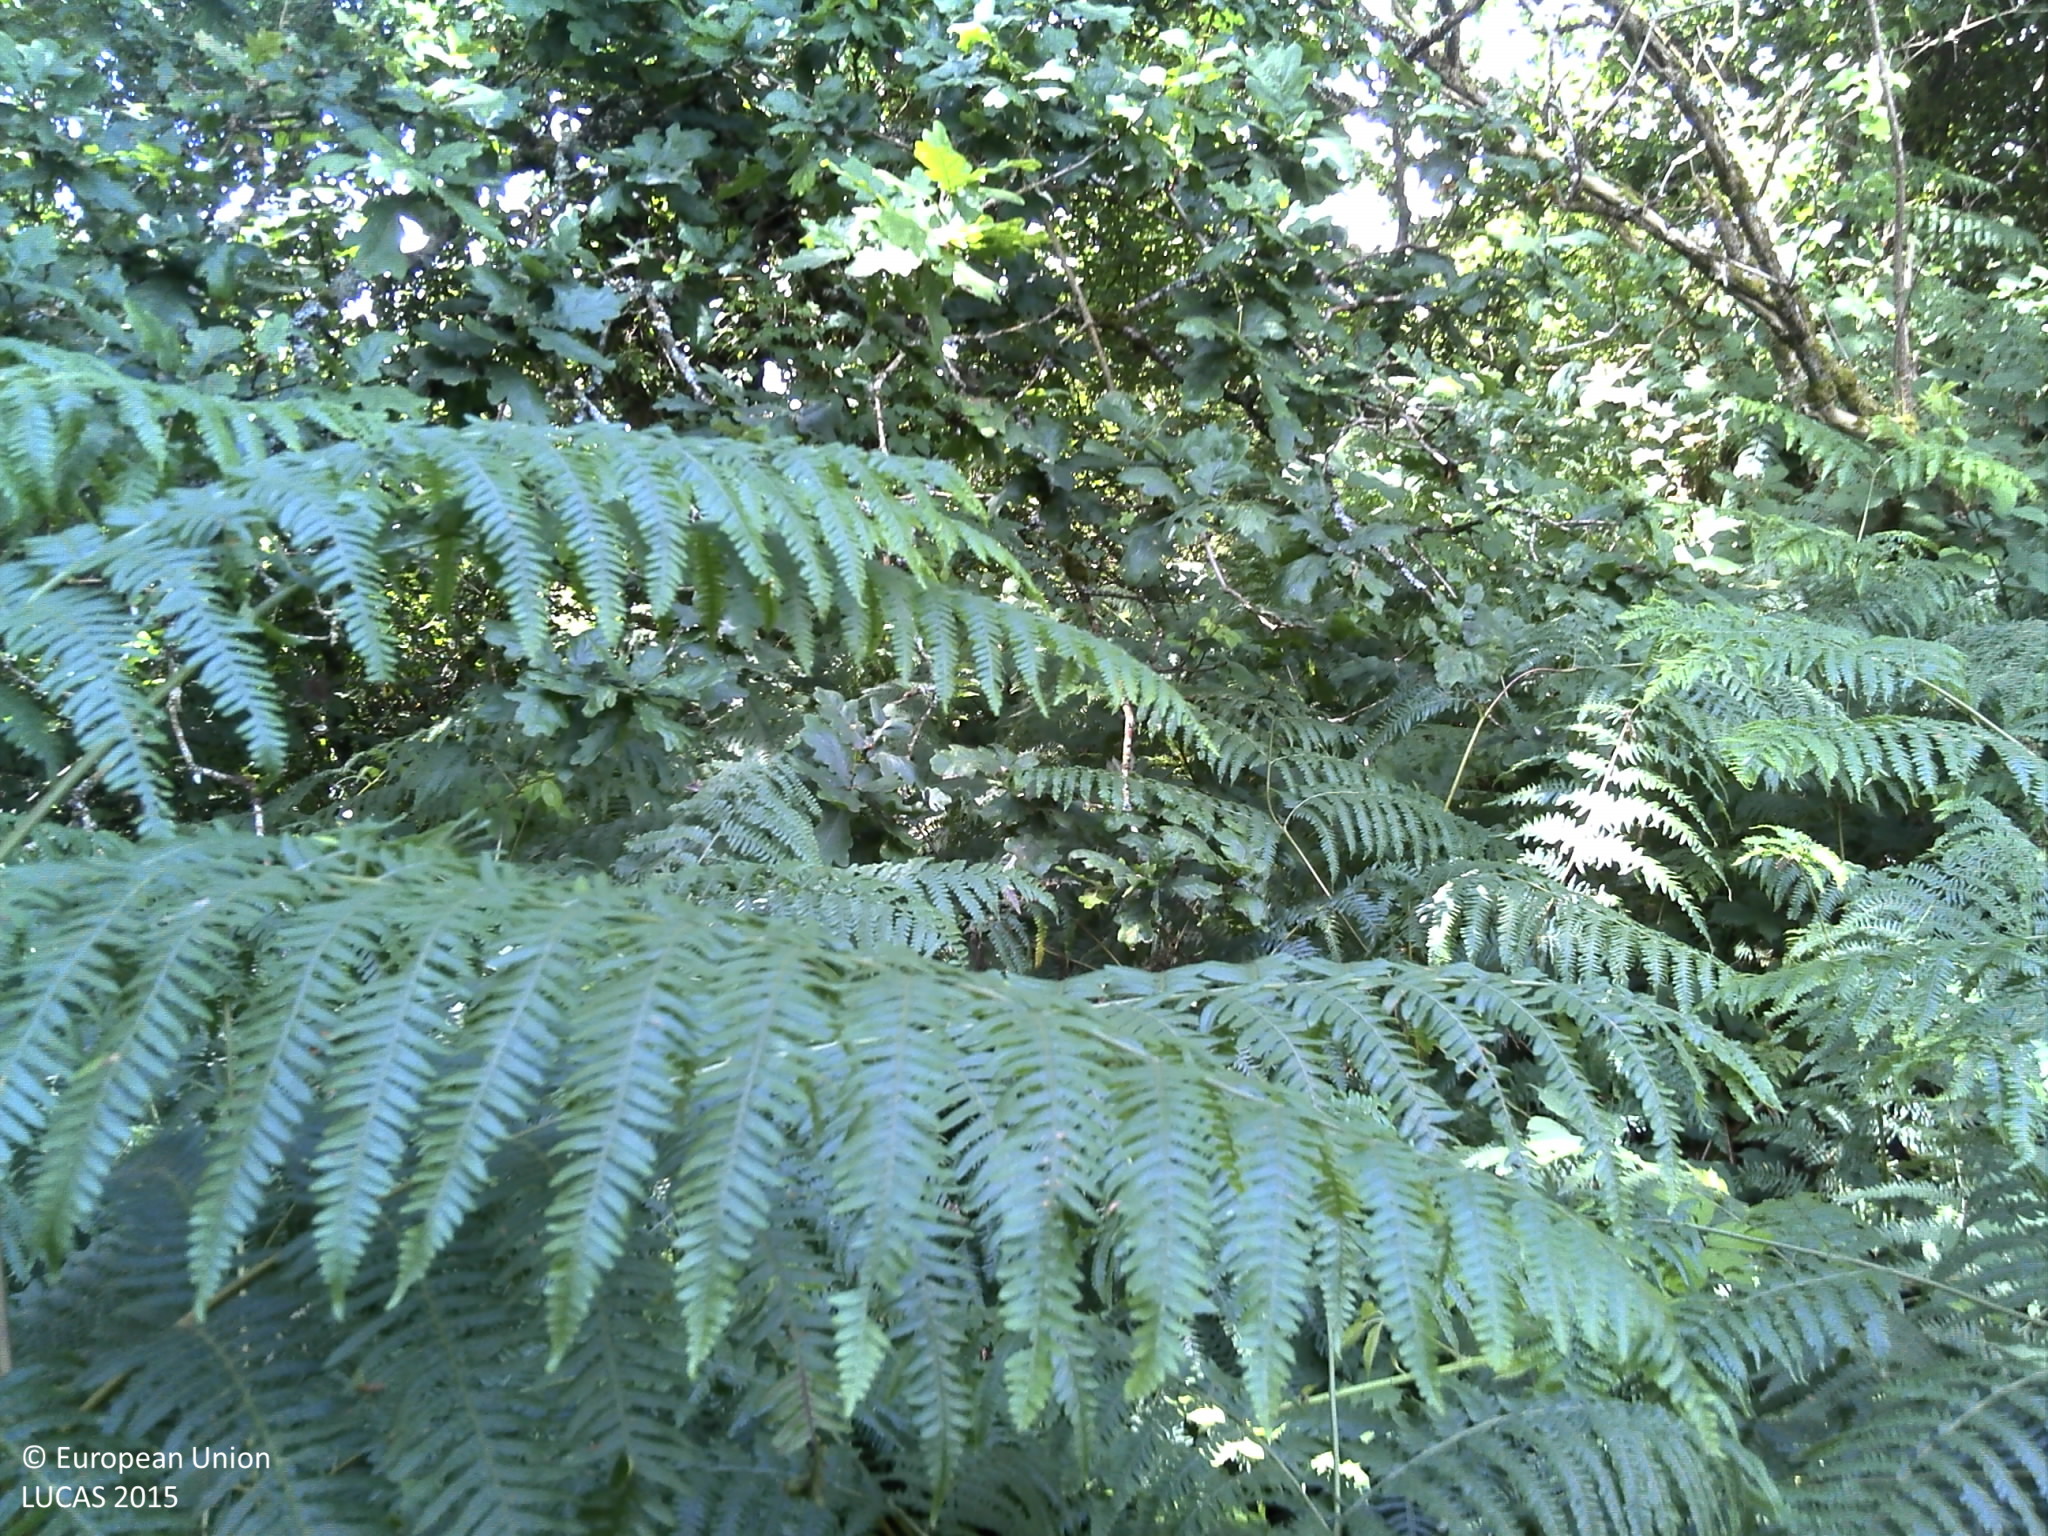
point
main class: Woodland
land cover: Broadleaved woodland
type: acidophilous oak and oak-birch forest
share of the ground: > 75 %
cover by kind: broadleaved forest trees 90 %, shrubs 5 %, herbaceous plants 5 %
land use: Semi-natural and natural areas not in use
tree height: > 5 m
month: July
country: FR
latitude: 48.3137
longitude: -3.6874
